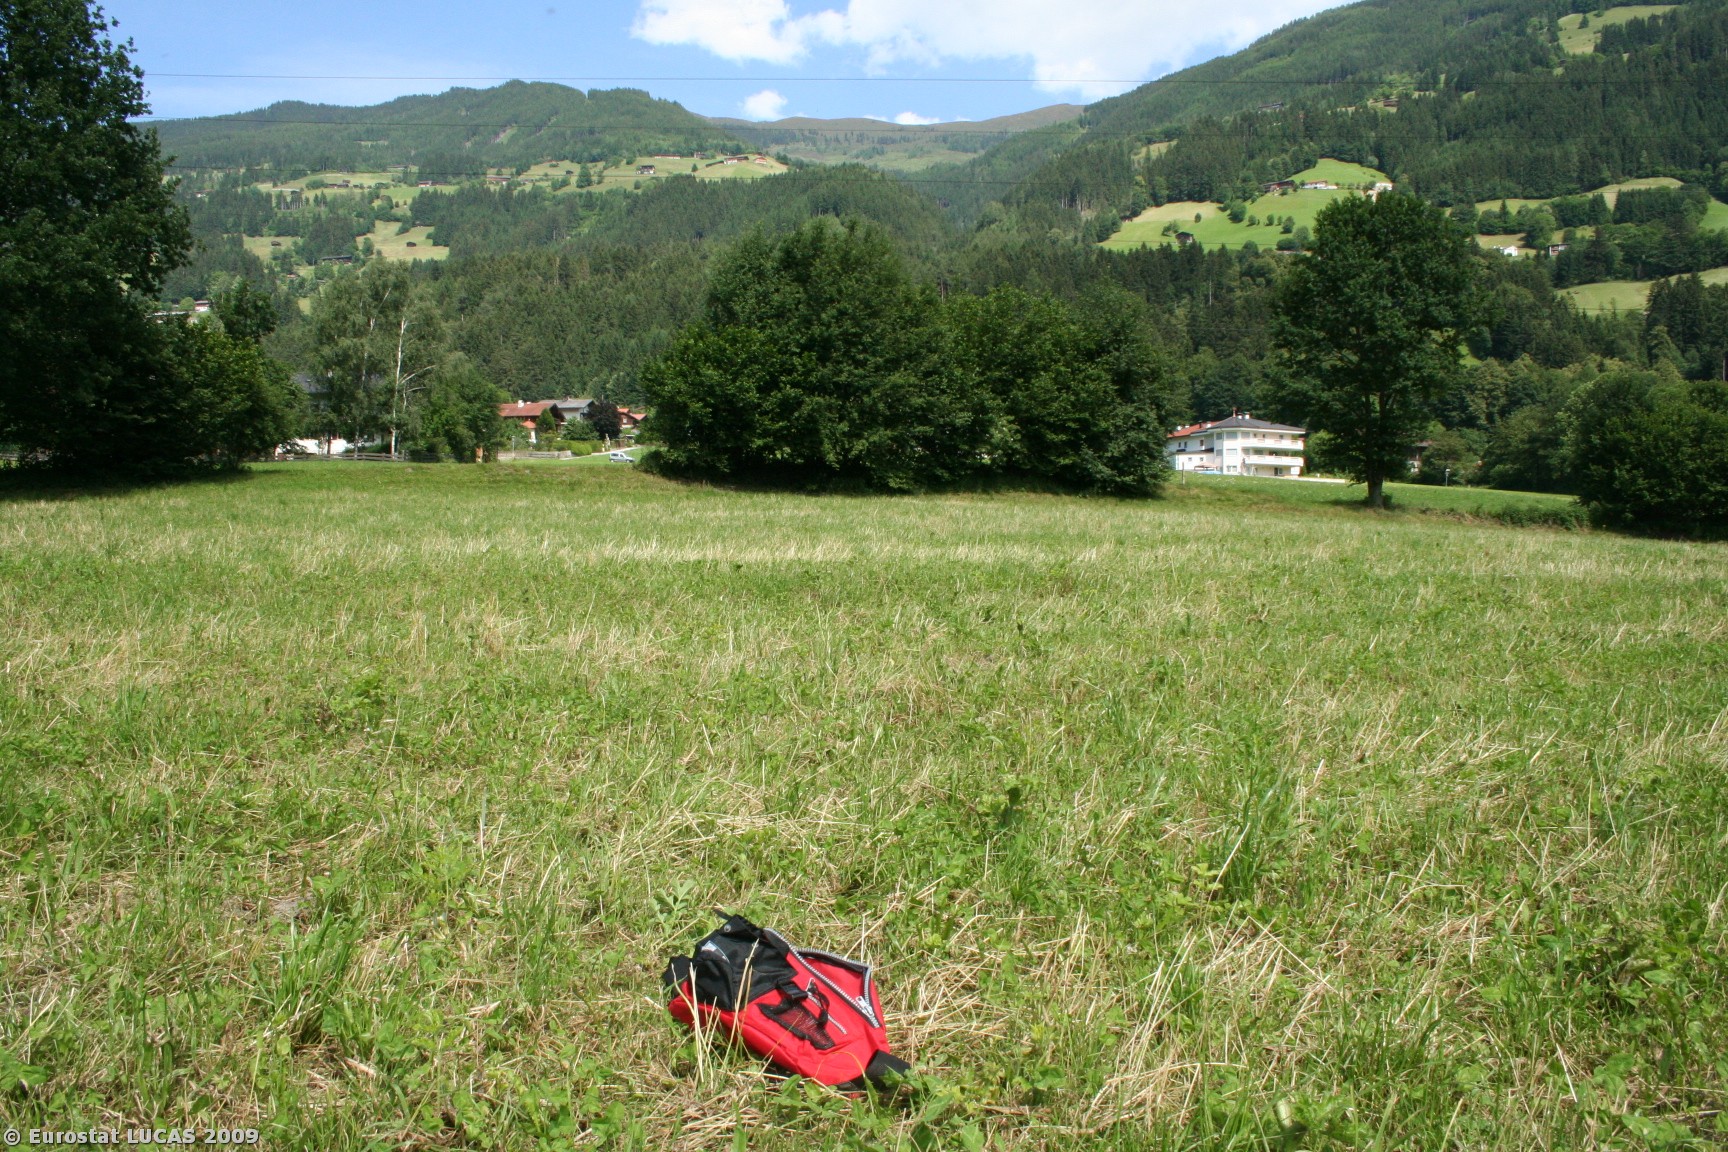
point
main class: Grassland
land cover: Grassland without tree/shrub cover
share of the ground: > 75 %
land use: Agriculture (excluding fallow land and kitchen gardens)
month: June
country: AT
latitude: 47.3436
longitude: 11.8647
